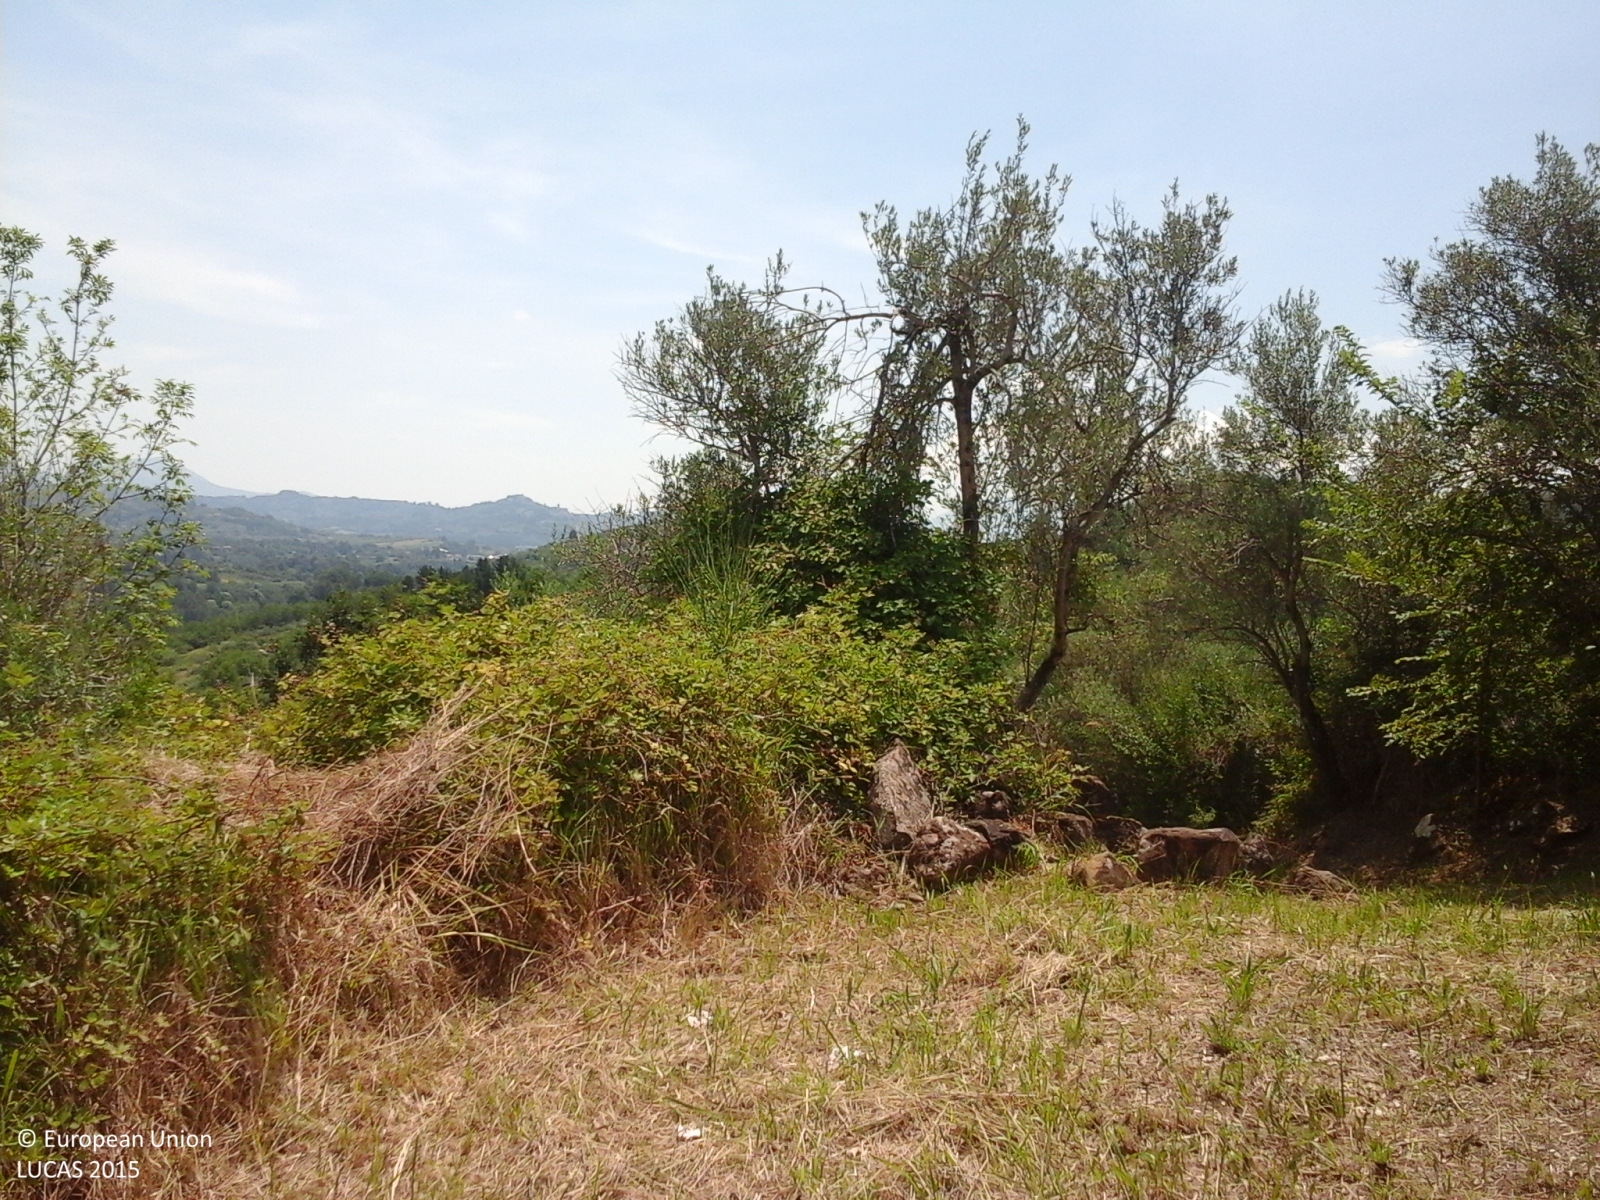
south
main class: Woodland
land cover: Broadleaved woodland
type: thermophilous deciduous forest
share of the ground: 25 - 50 %
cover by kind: broadleaved forest trees 70 %, herbaceous plants 20 %, shrubs 10 %
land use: Semi-natural and natural areas not in use
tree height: < 5 m
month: June
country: IT
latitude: 41.8507
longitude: 12.9881
